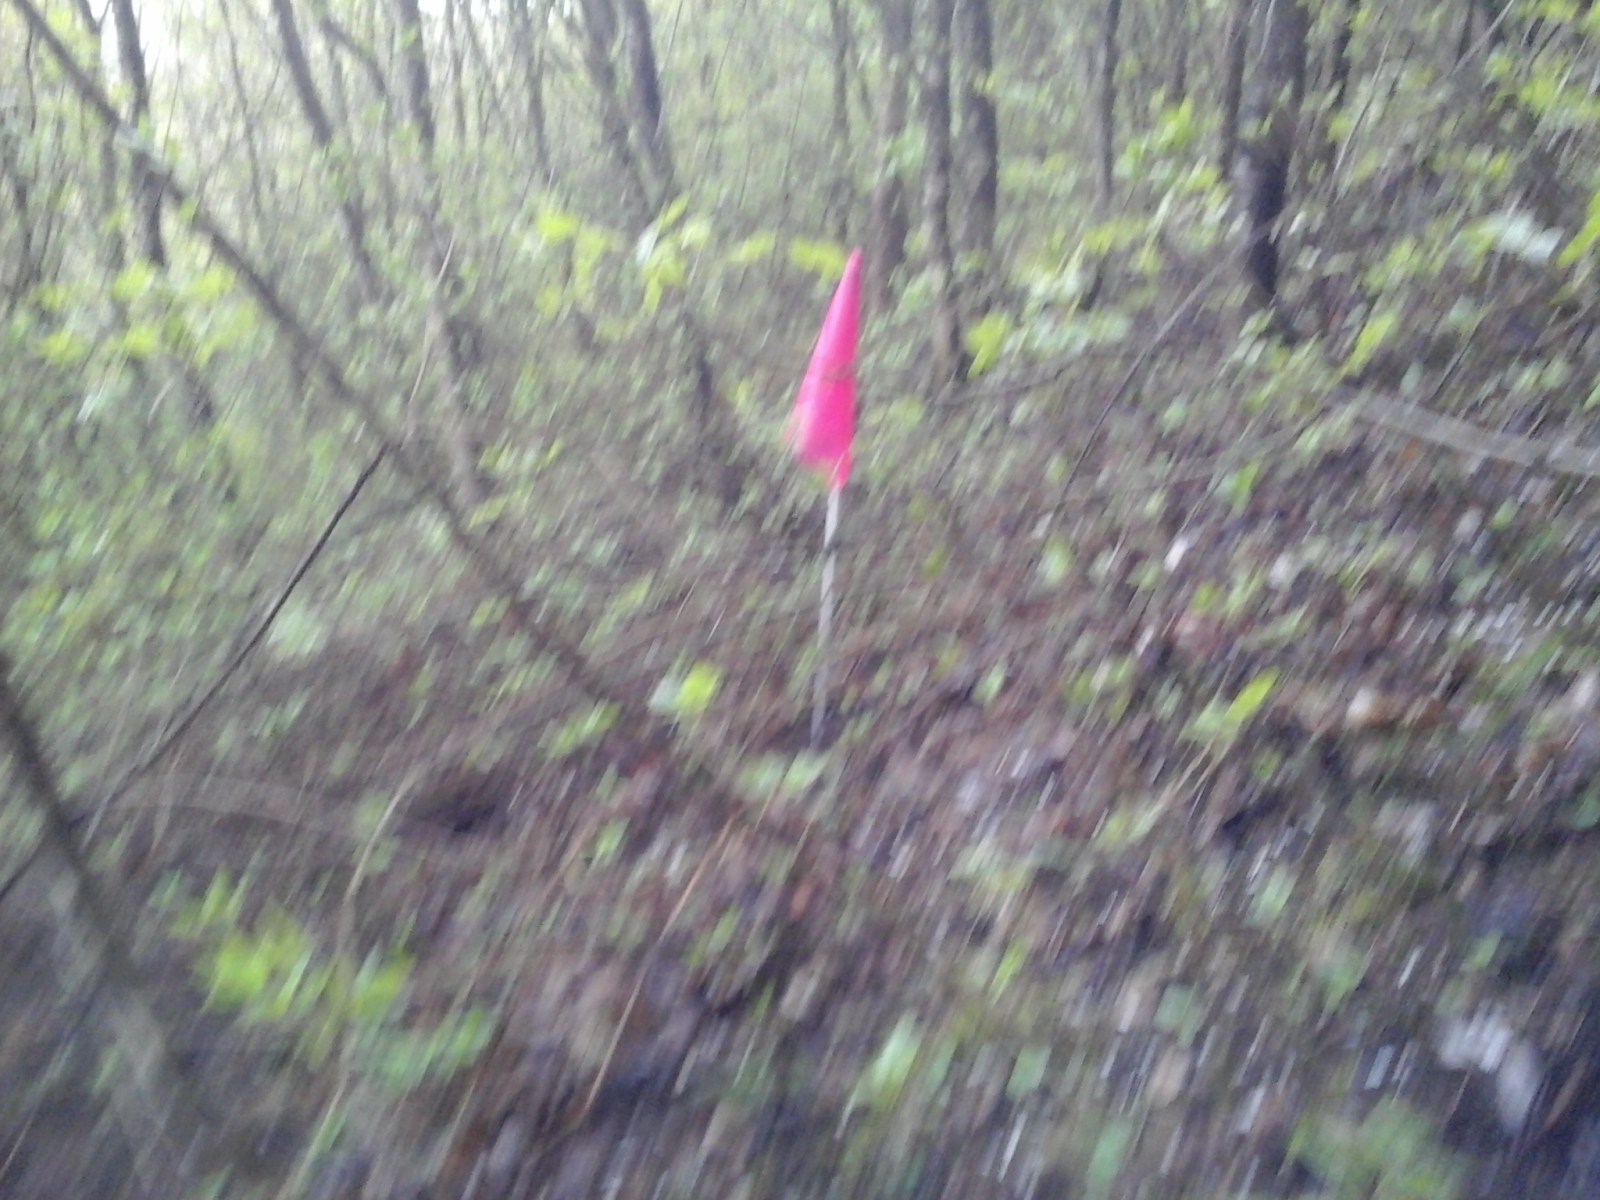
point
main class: Woodland
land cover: Other mixed woodland
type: mesophytic deciduous forest
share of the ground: > 75 %
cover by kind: broadleaved forest trees 75 %, coniferous forest trees 25 %
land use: Forestry
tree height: > 5 m
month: May
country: IT
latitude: 46.4353
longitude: 11.1309
